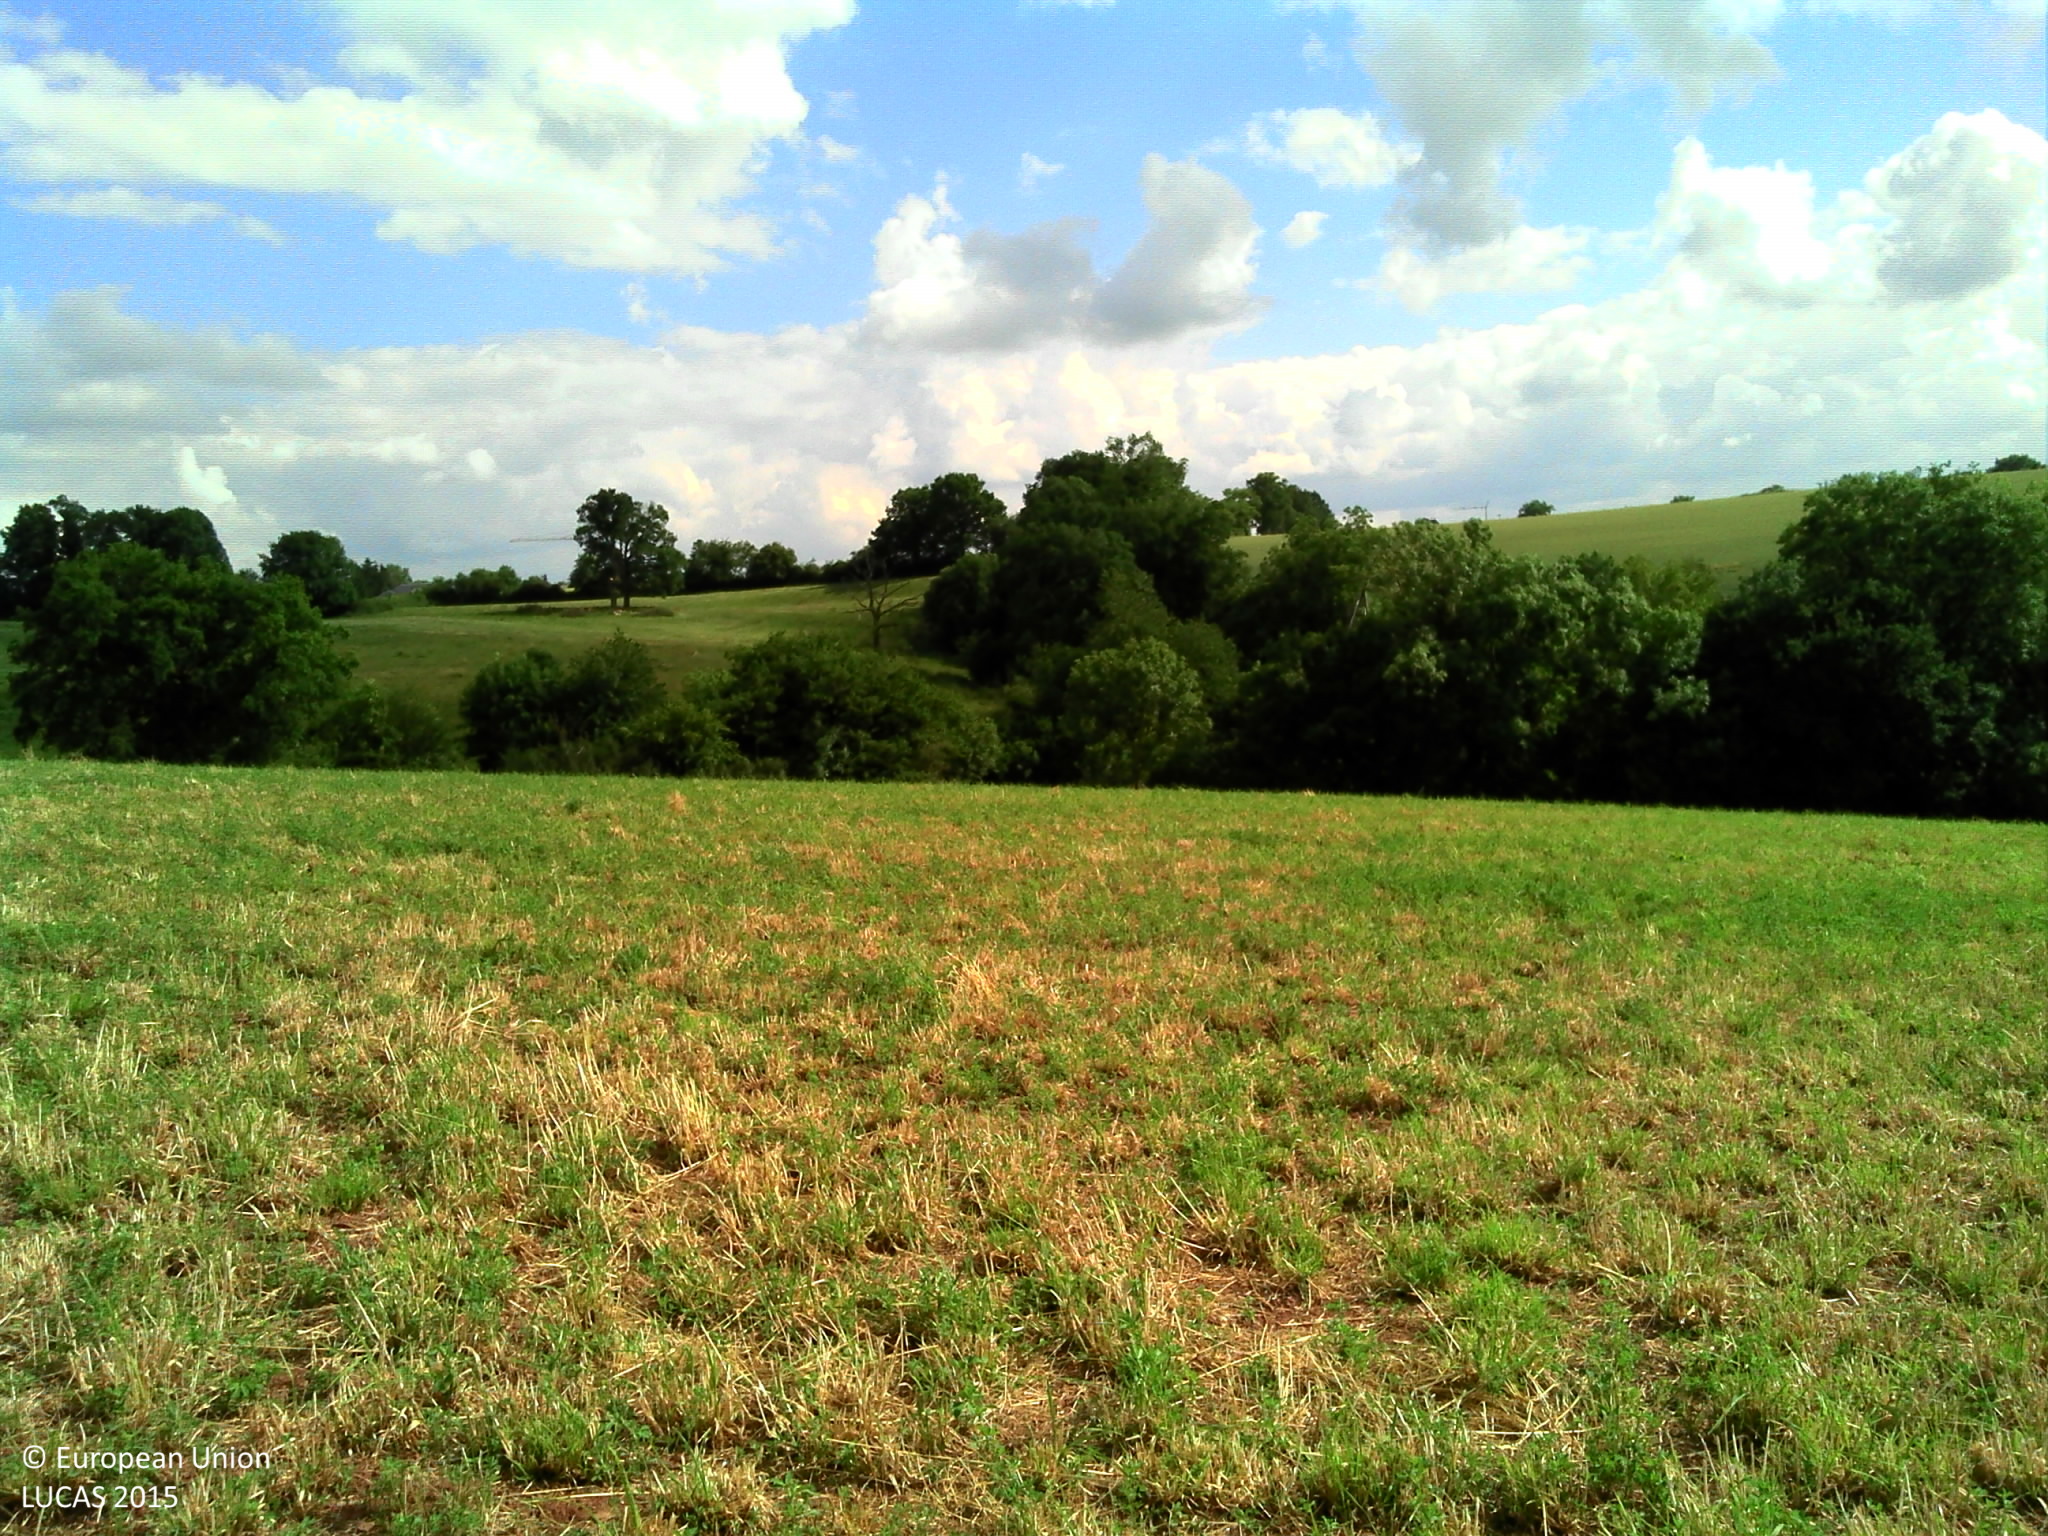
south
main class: Cropland
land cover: Lucerne
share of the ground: 50 - 75 %
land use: Agriculture (excluding fallow land and kitchen gardens)
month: June
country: FR
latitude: 44.3372
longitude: 2.5659
